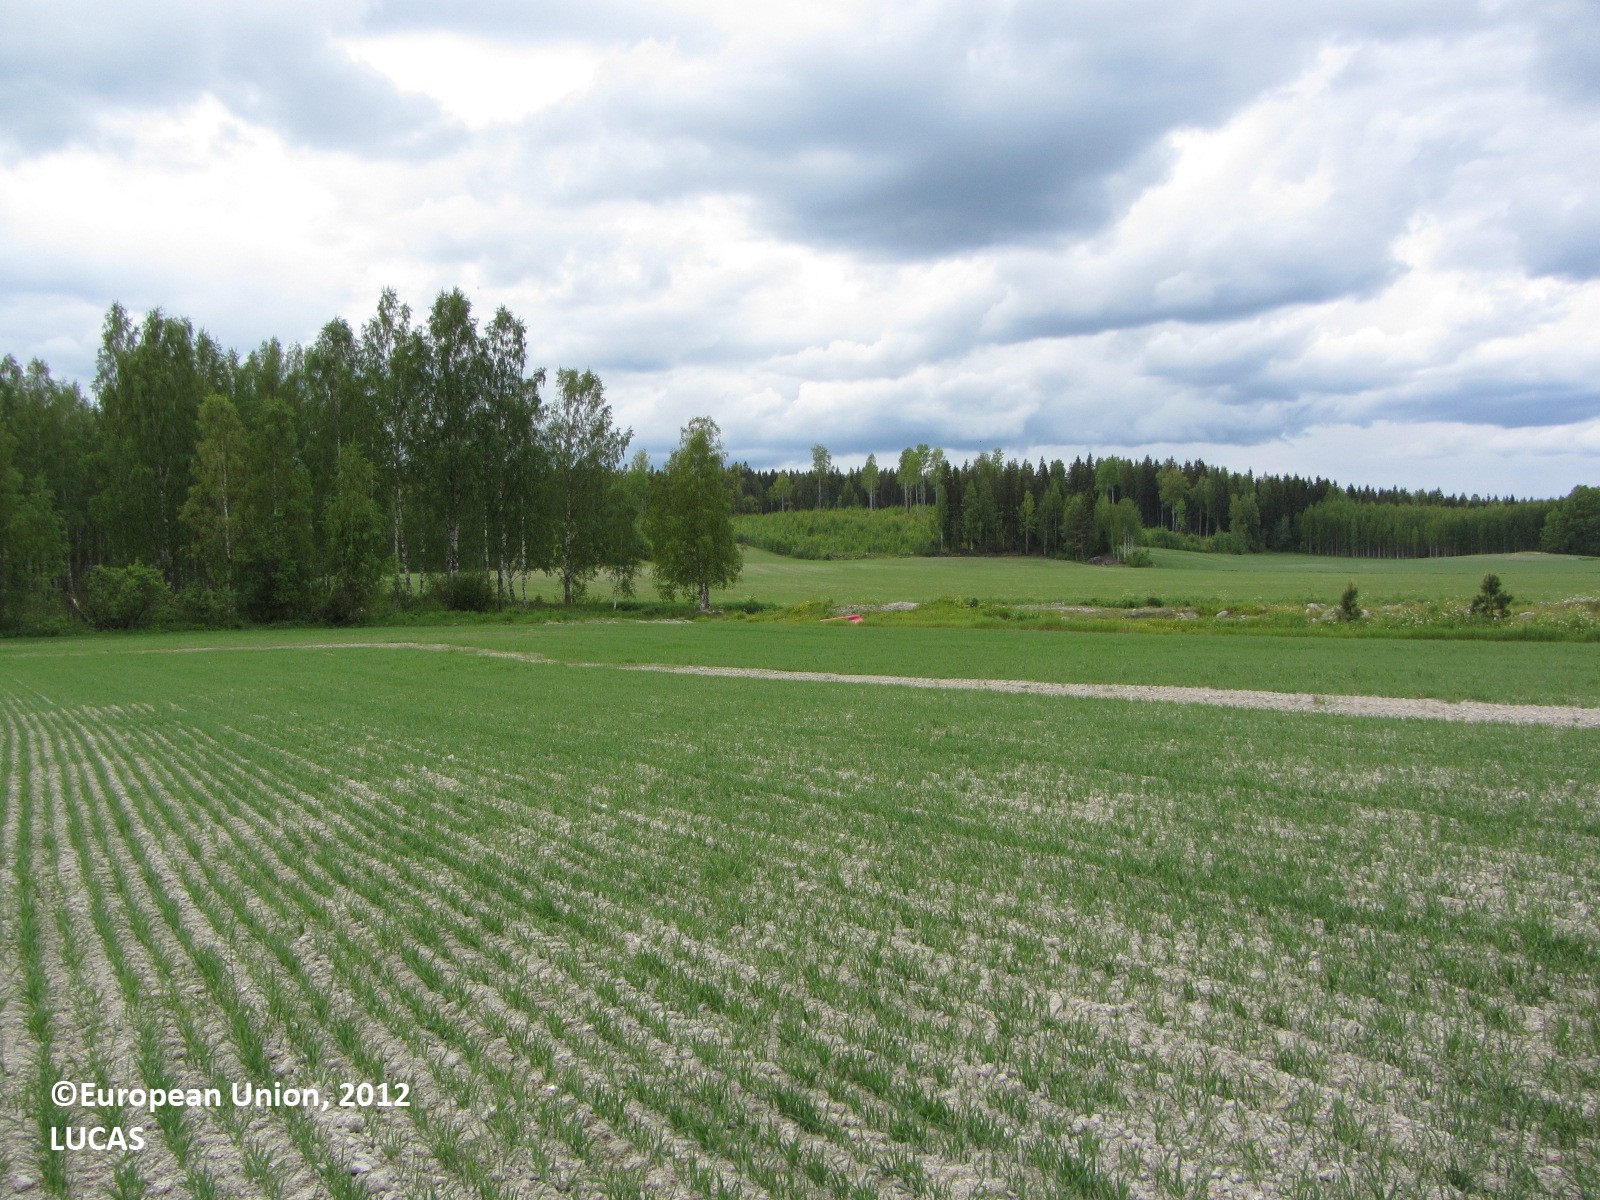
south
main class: Cropland
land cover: Oats
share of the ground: 50 - 75 %
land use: Agriculture (excluding fallow land and kitchen gardens)
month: June
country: FI
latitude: 61.7095
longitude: 24.7993
